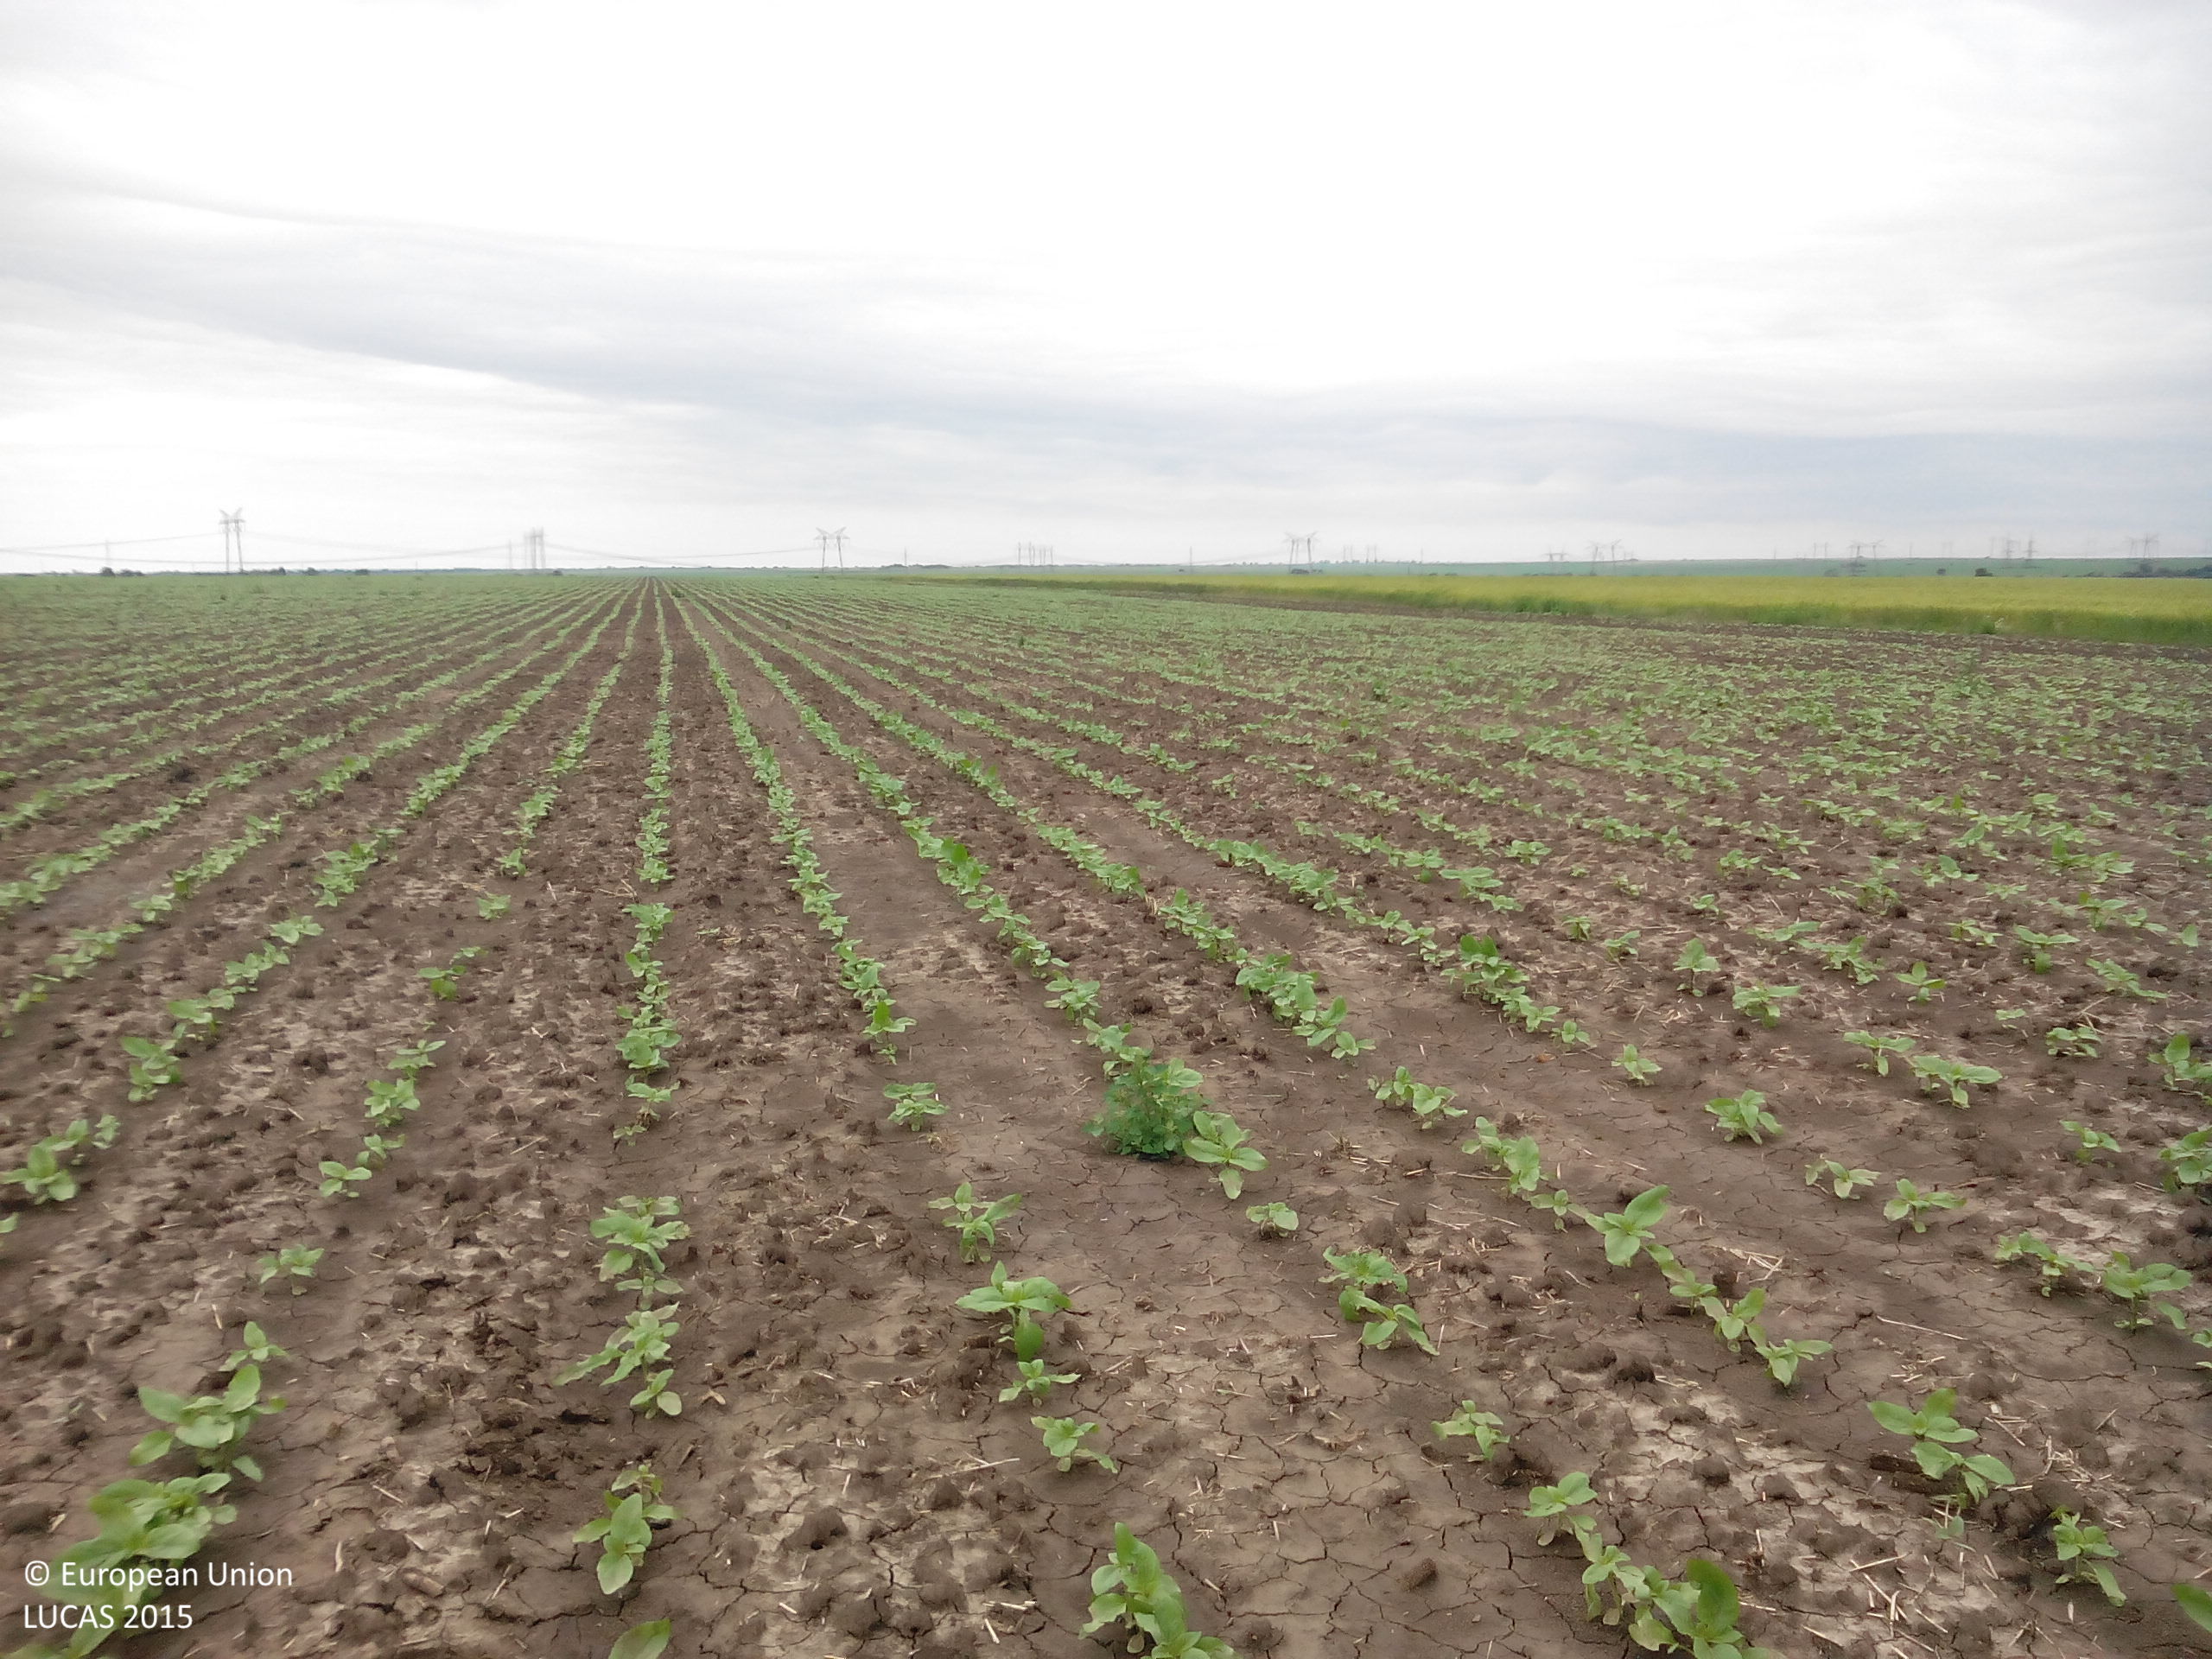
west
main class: Cropland
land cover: Sunflower
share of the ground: < 10 %
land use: Agriculture (excluding fallow land and kitchen gardens)
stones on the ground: < 10 %
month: May
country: BG
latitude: 43.5101
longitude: 23.9681
